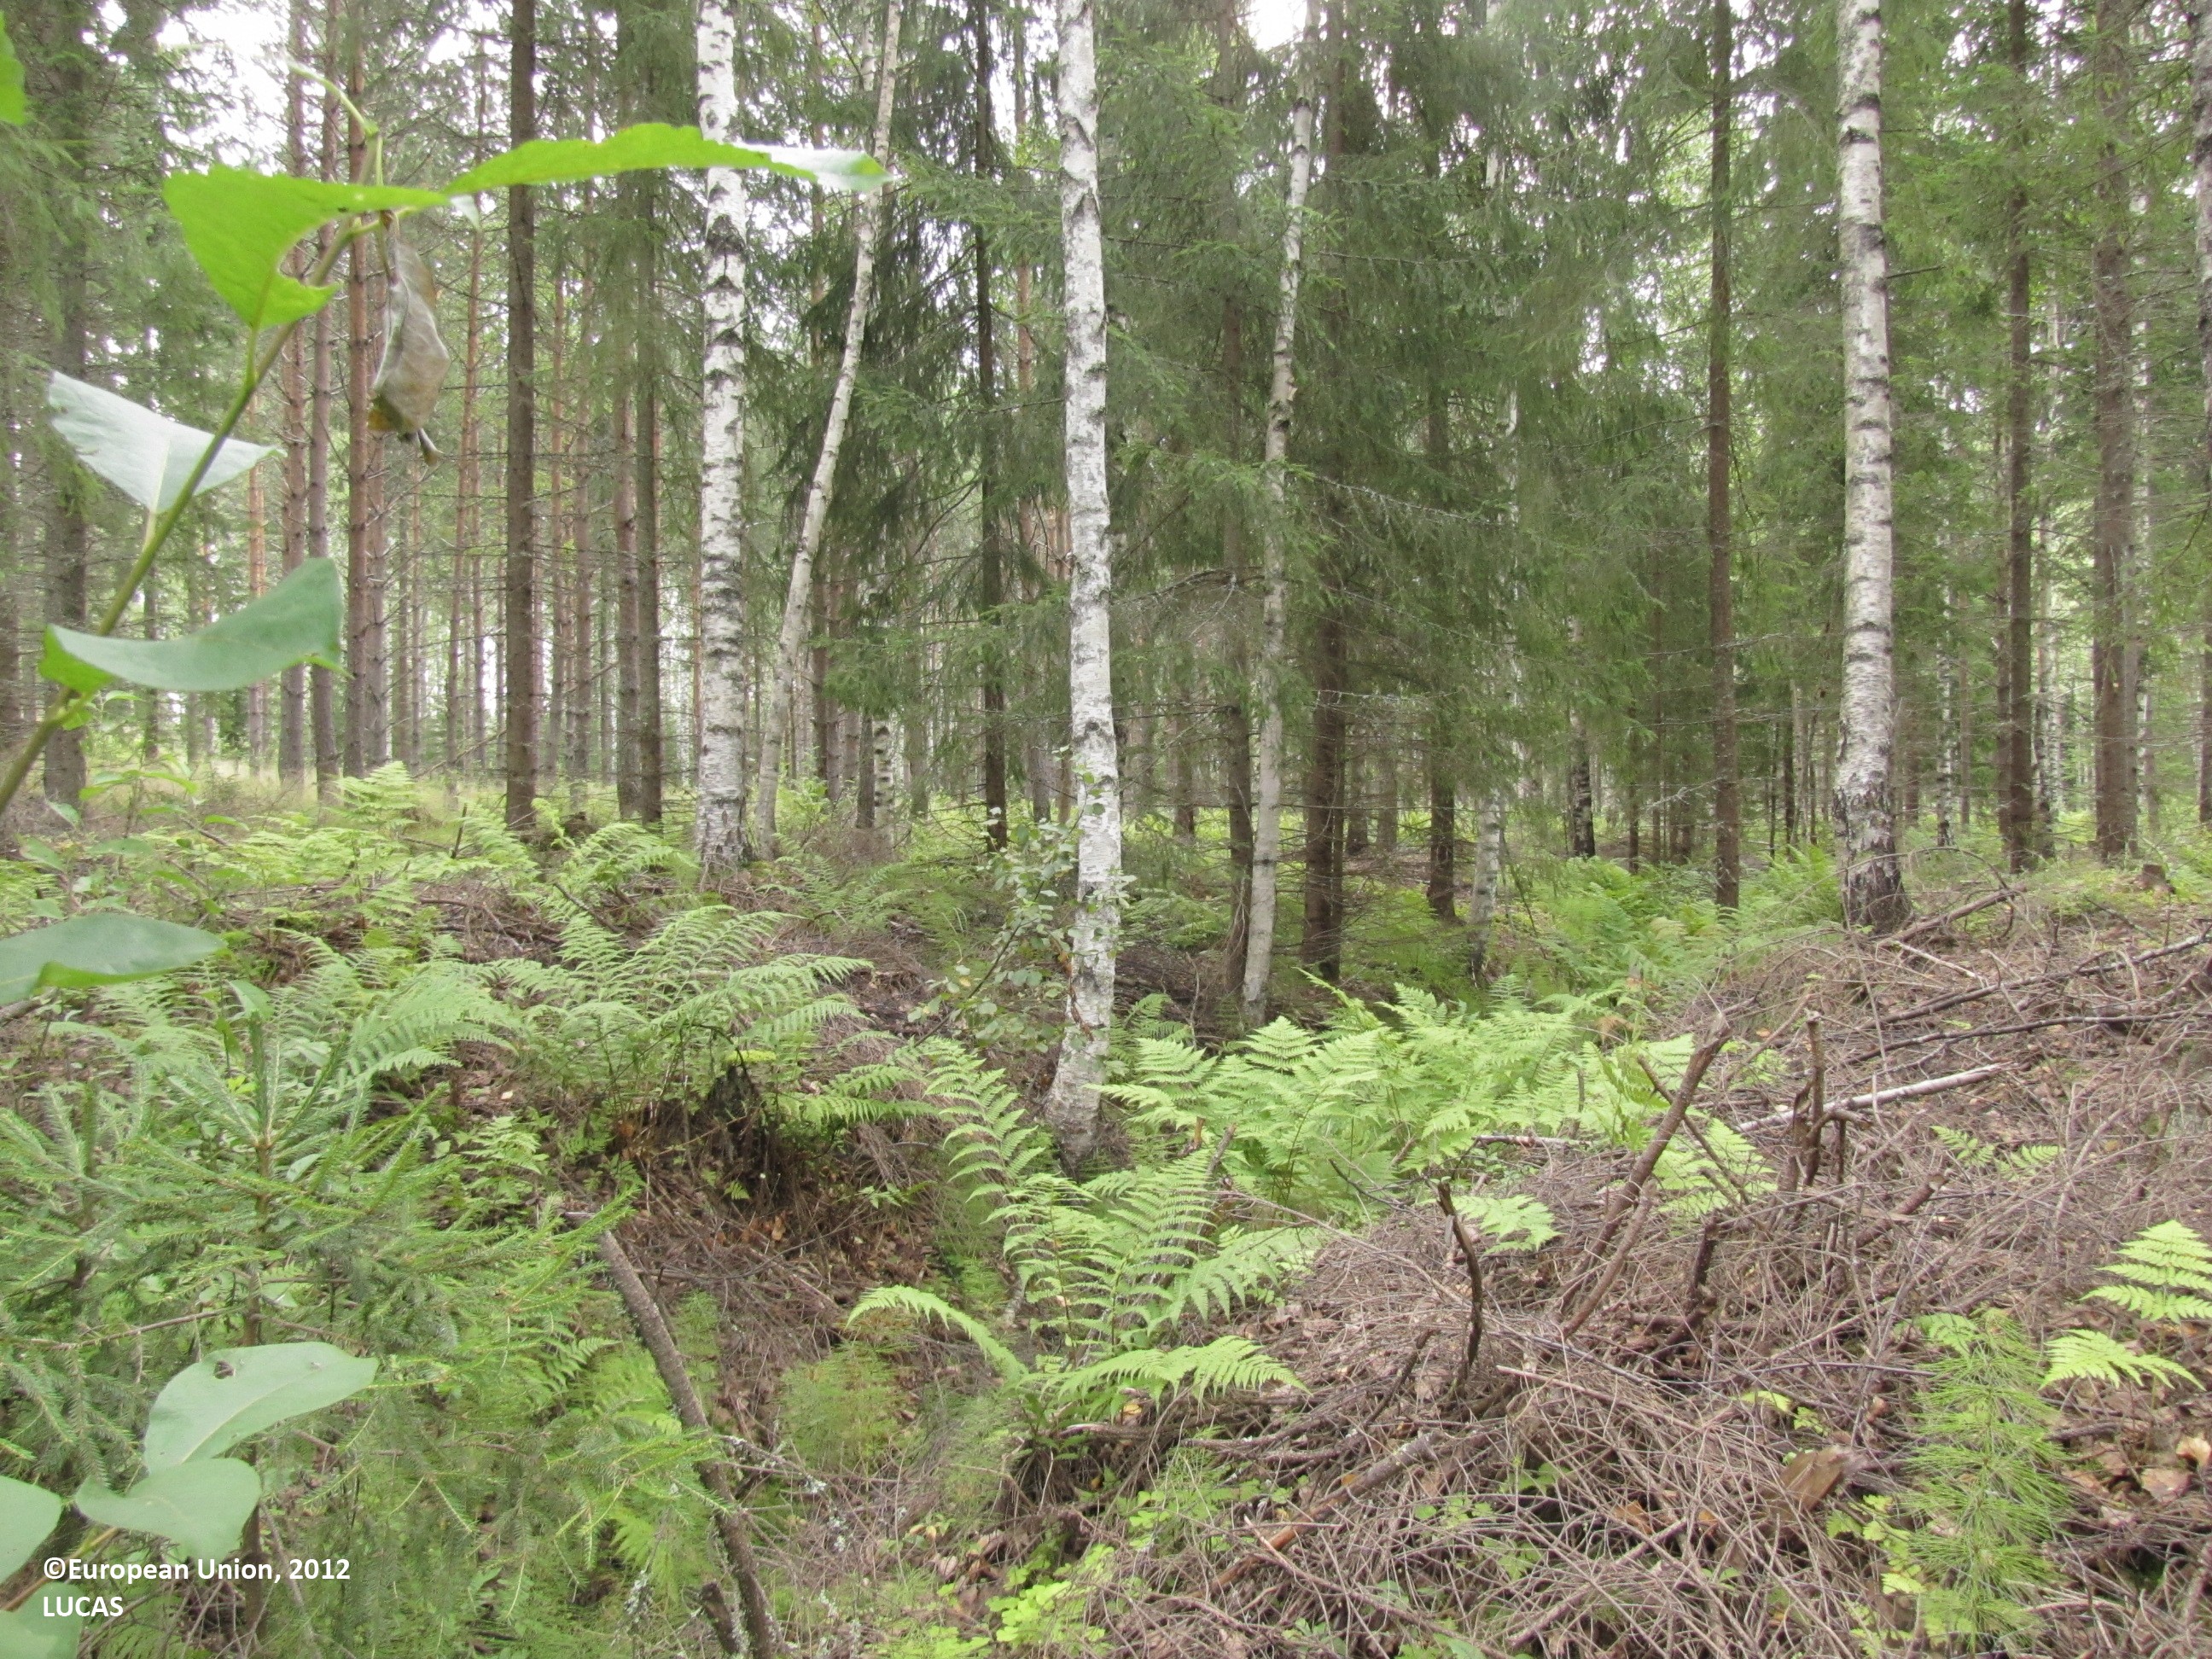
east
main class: Woodland
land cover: Other mixed woodland
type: boreal forest
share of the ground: 50 - 75 %
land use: Forestry
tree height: > 5 m
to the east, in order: Other mixed woodland; Ditches and canals; Other mixed woodland; Pine dominated coniferous woodland; Other mixed woodland; Ditches and canals; Pine dominated mixed woodland; Ditches and canals; Spruce dominated coniferous woodland
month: August
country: FI
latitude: 61.8956
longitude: 23.8401
